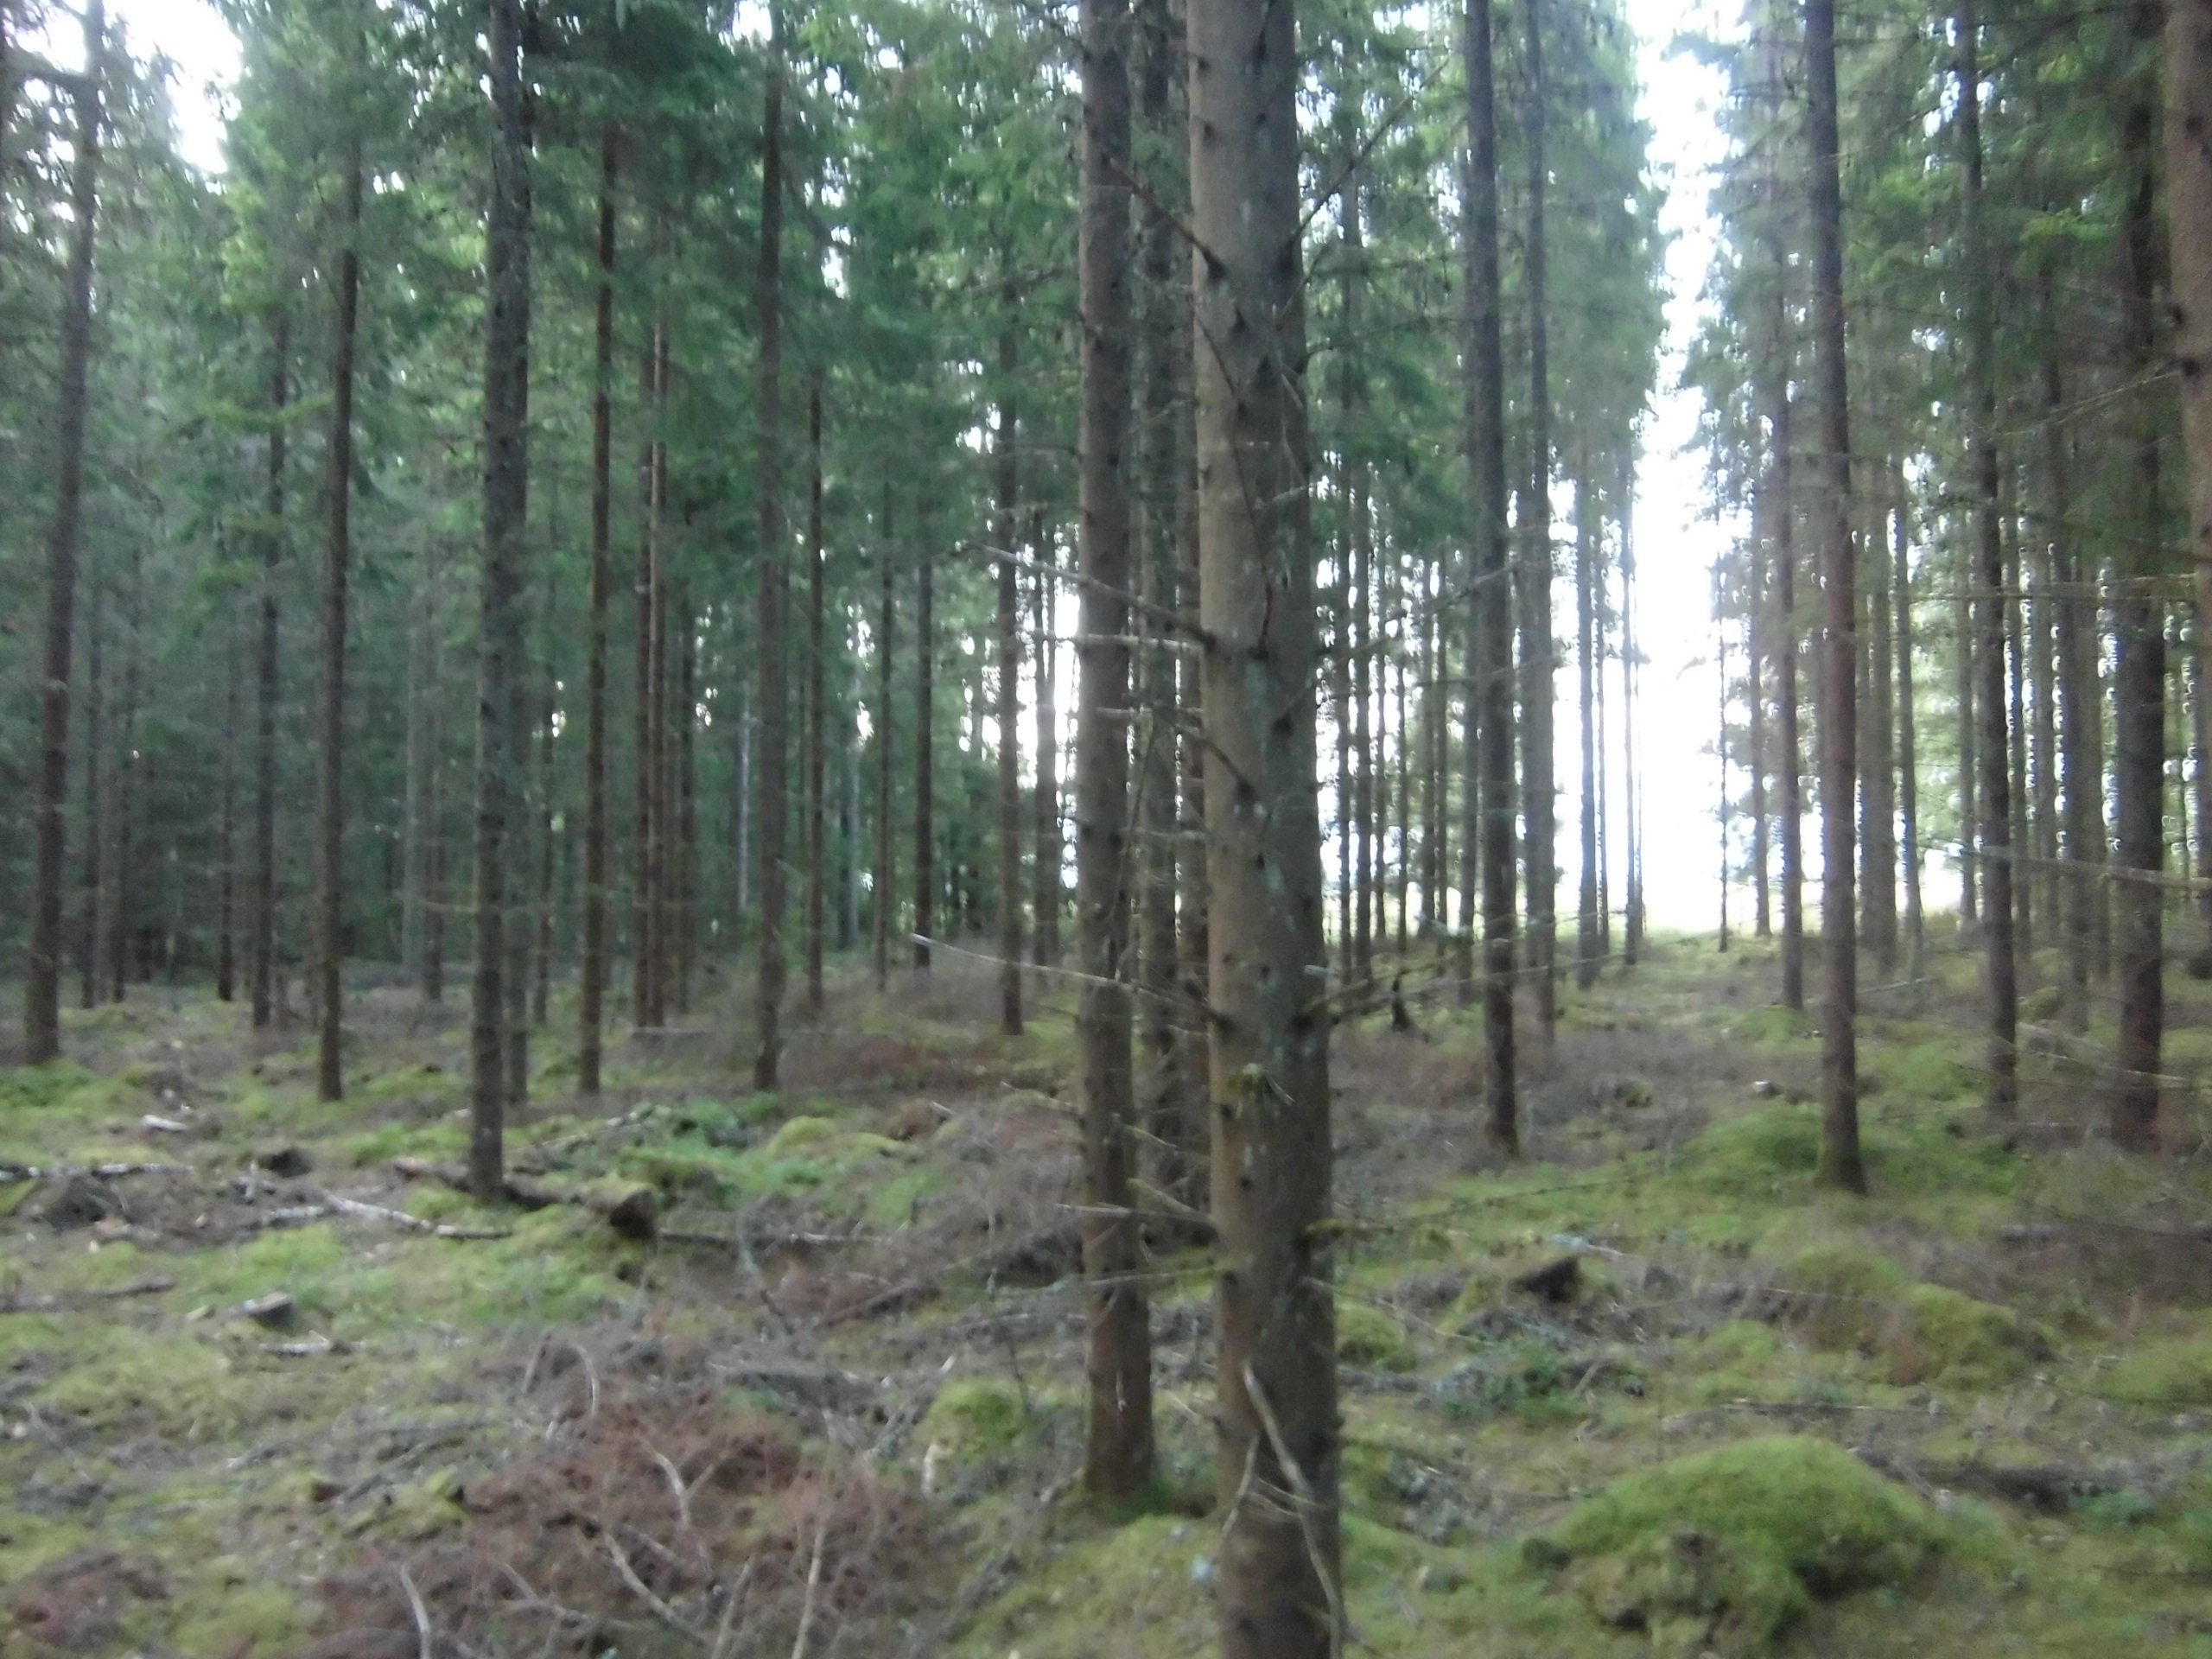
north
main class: Woodland
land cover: Spruce dominated coniferous woodland
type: boreal forest
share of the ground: 50 - 75 %
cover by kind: coniferous forest trees 65 %, shrubs 15 %, lichens and mosses 15 %, herbaceous plants 5 %
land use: Forestry
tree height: > 5 m
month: July
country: SE
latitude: 57.4475
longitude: 14.8450
